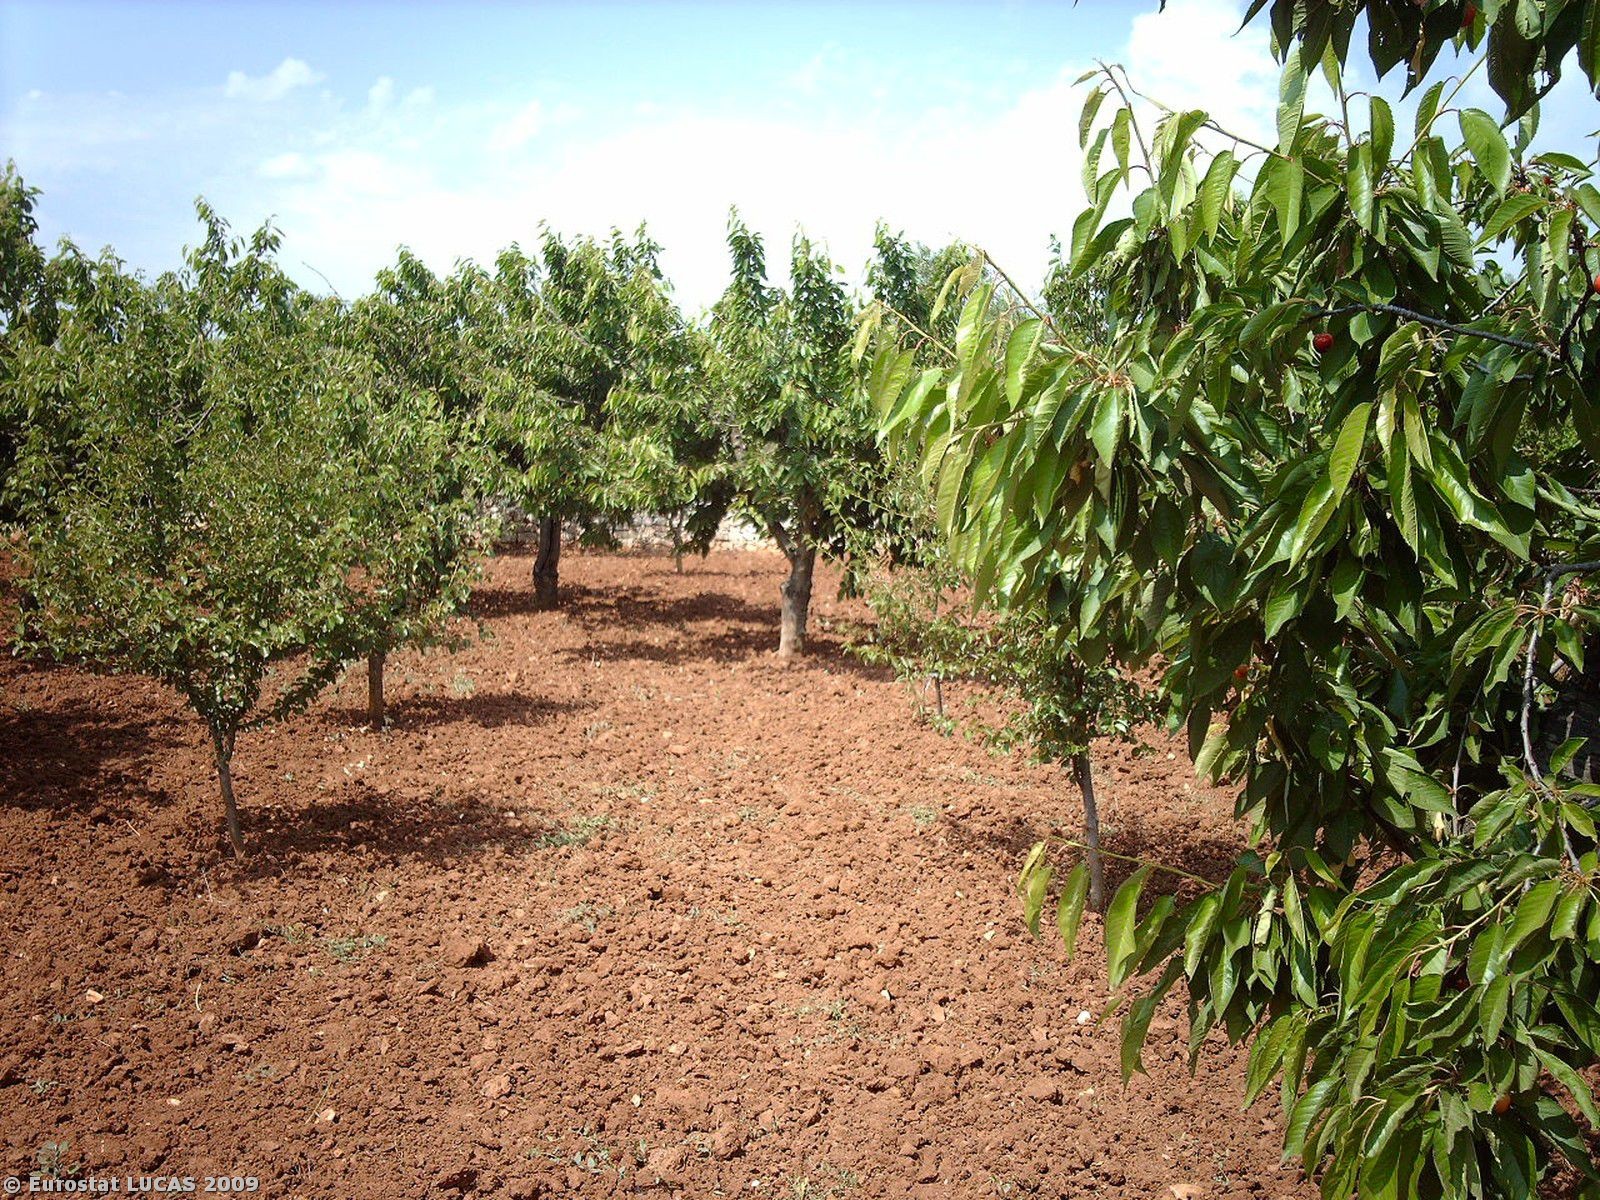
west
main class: Cropland
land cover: Cherry fruit
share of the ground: 50 - 75 %
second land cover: Olive groves
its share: 10 - 25 %
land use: Agriculture (excluding fallow land and kitchen gardens)
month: May
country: IT
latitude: 40.9070
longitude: 16.9944
